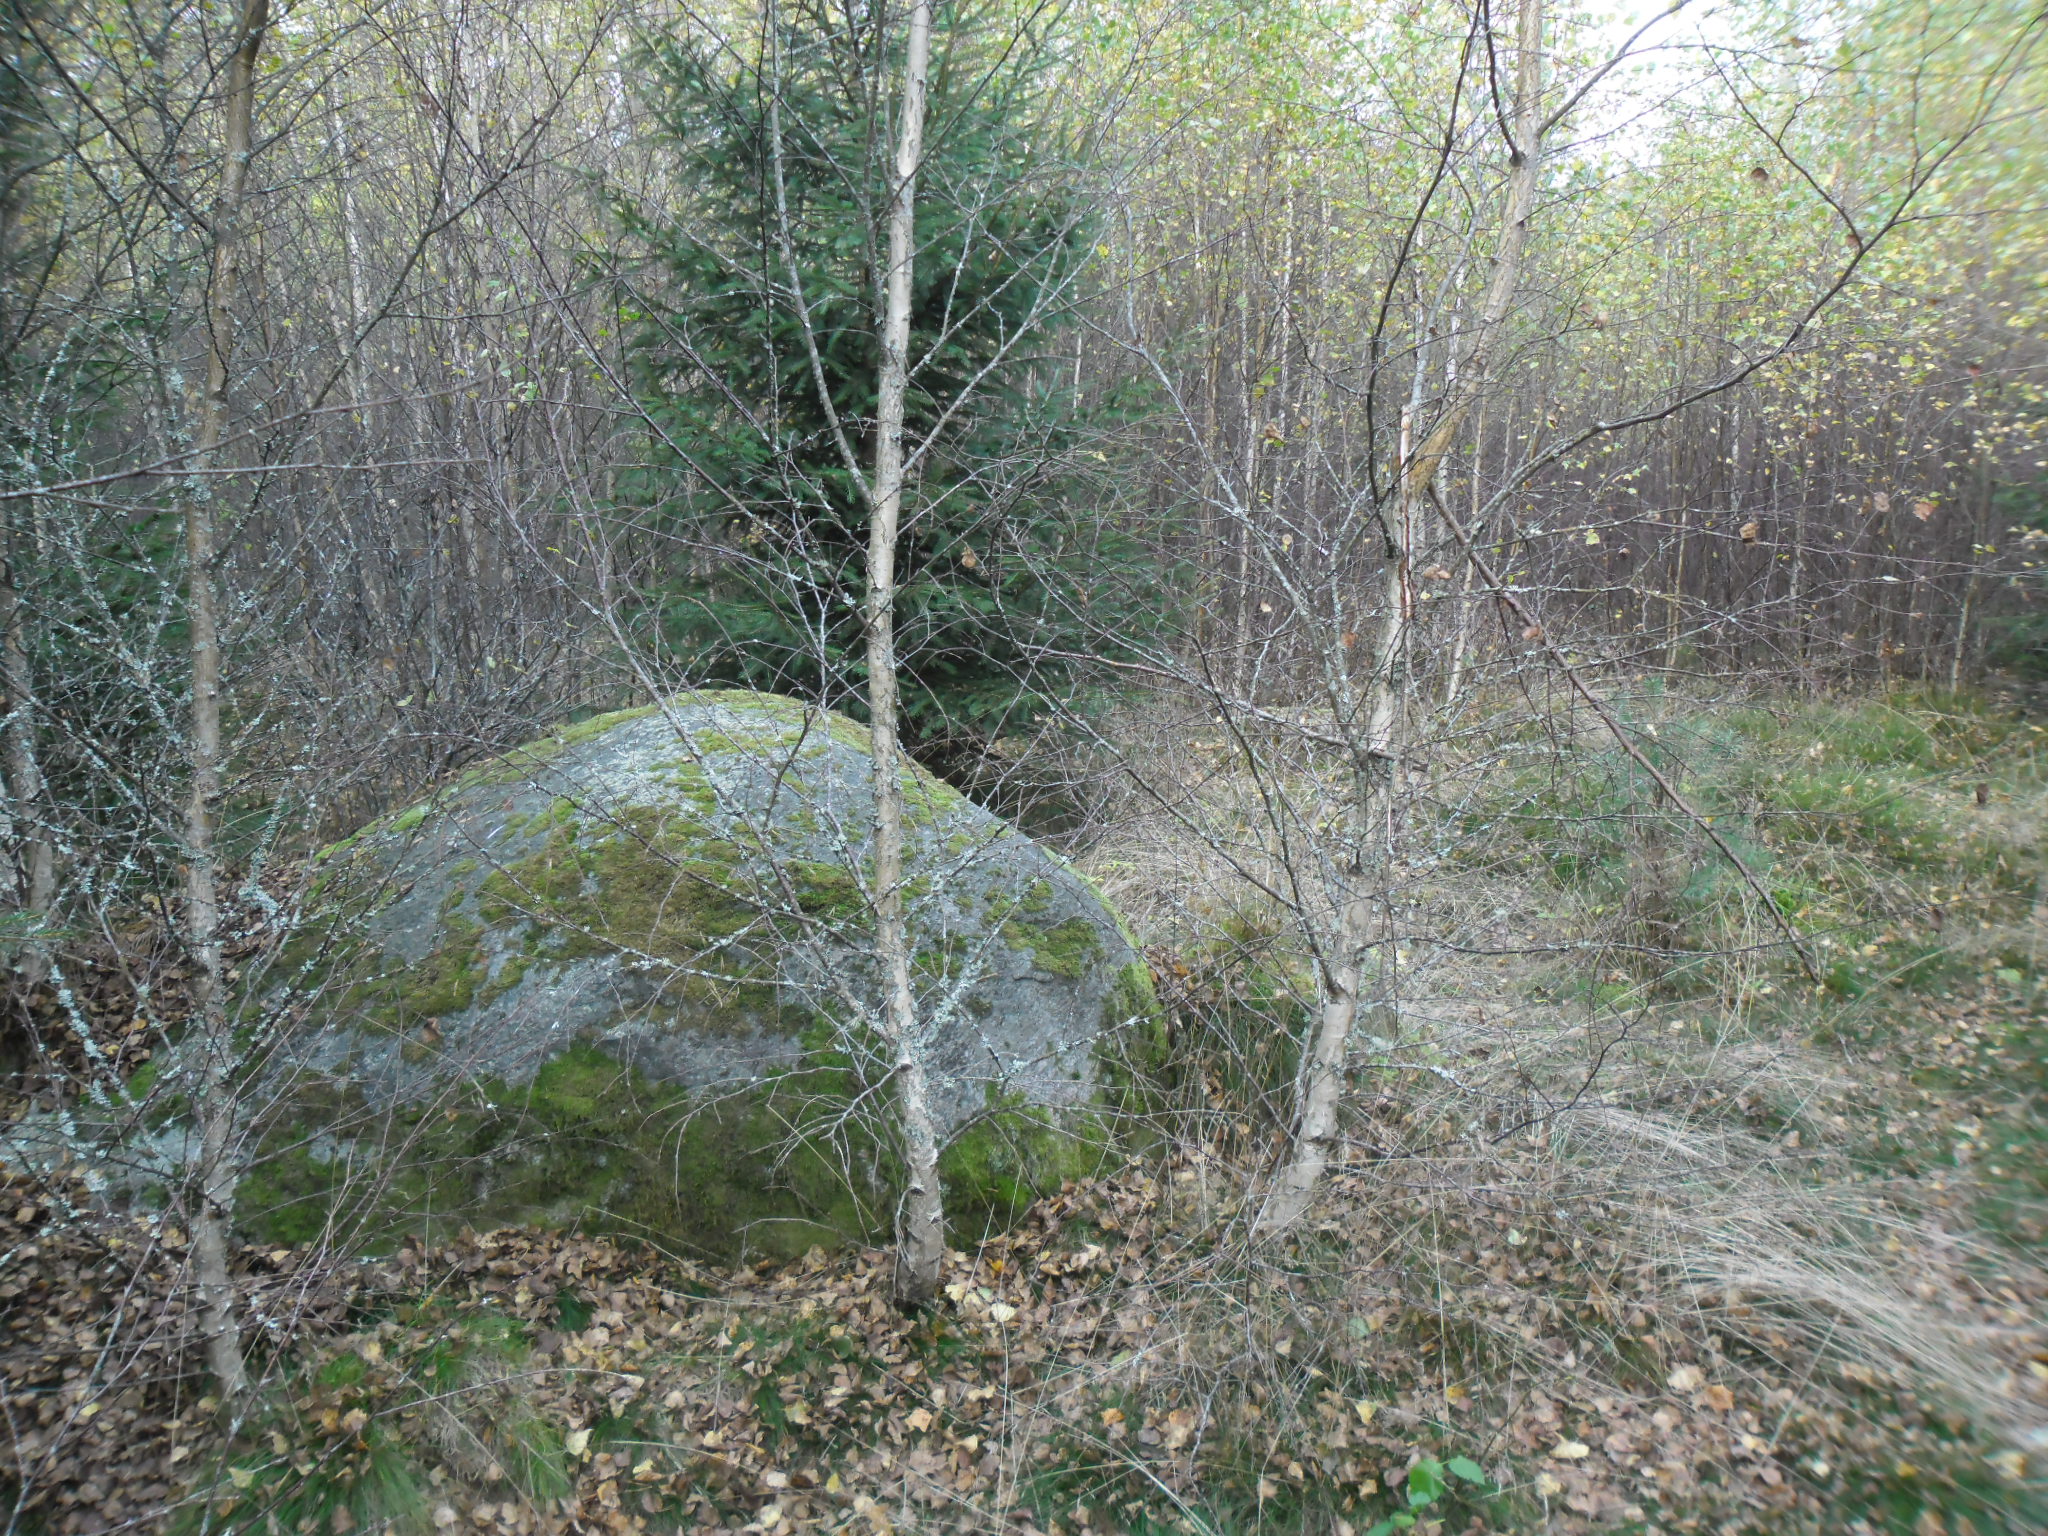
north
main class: Woodland
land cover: Spruce dominated mixed woodland
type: boreal forest
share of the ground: > 75 %
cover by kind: coniferous forest trees 60 %, broadleaved forest trees 30 %, herbaceous plants 10 %
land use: Forestry
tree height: < 5 m
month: October
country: SE
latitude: 56.2947
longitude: 13.7621
